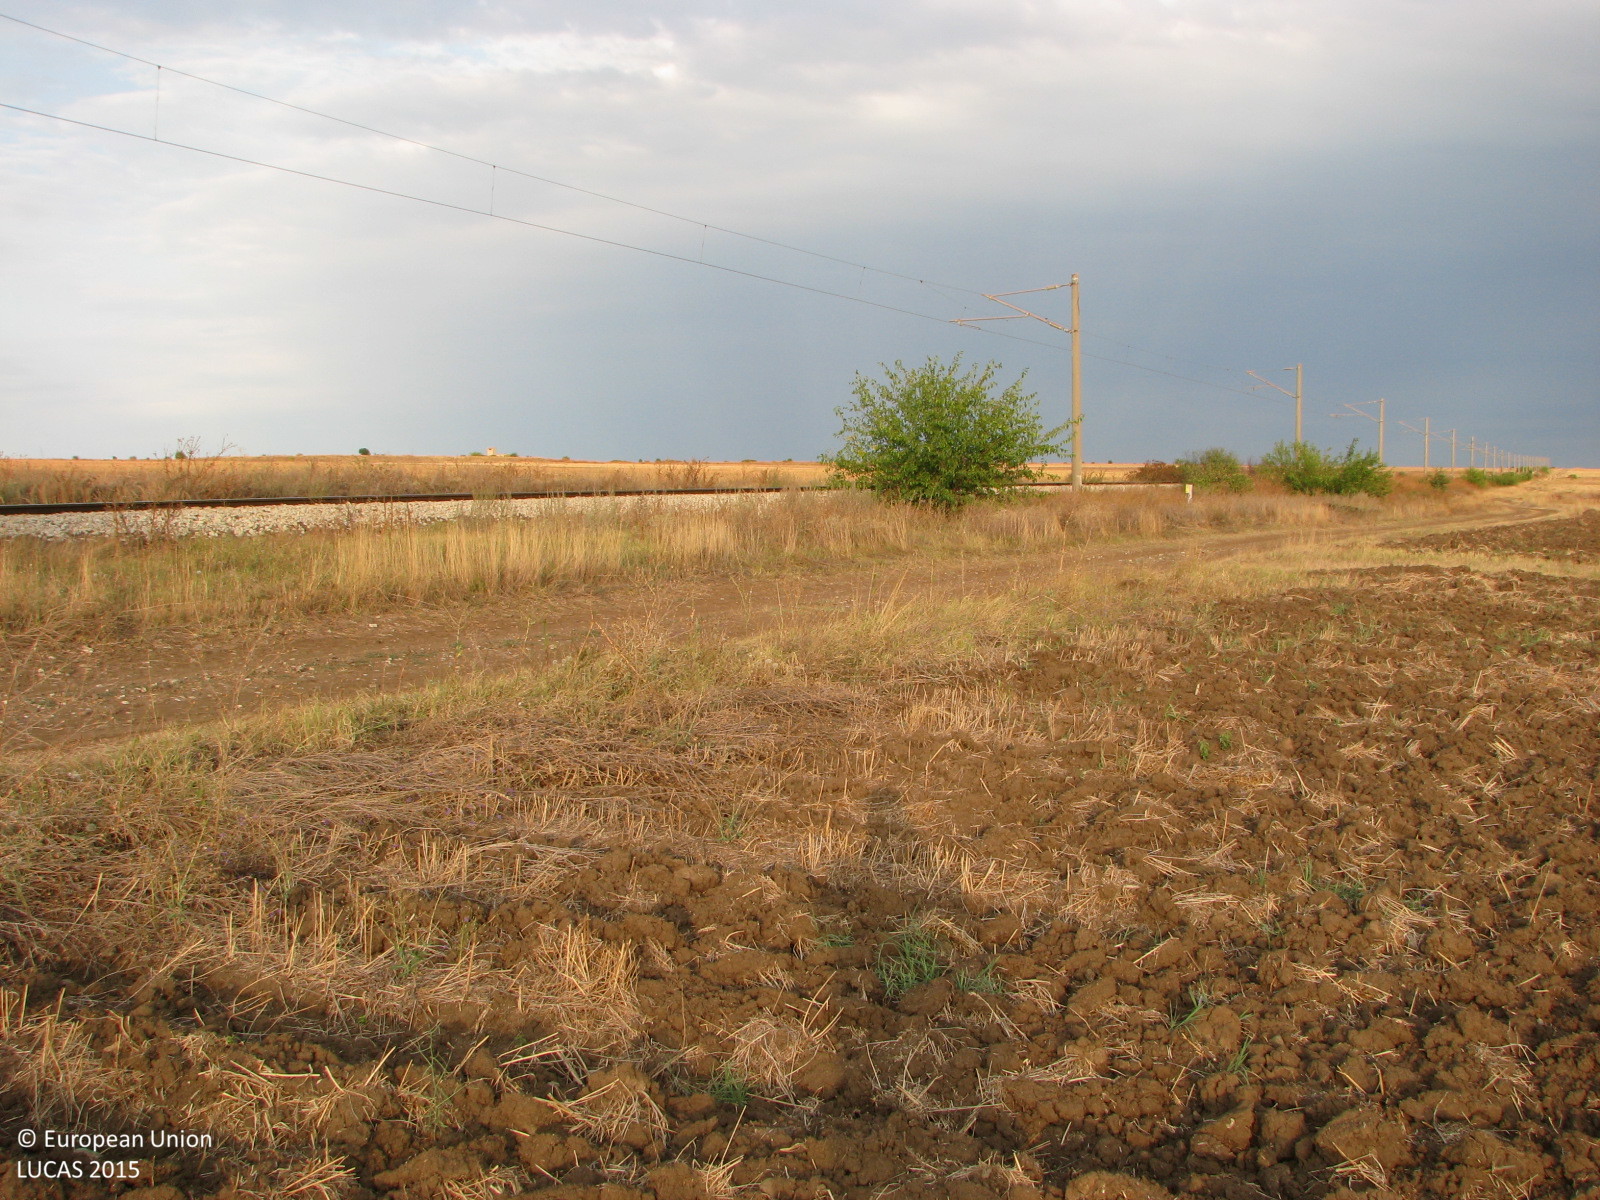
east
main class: Cropland
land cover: Common wheat
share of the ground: < 10 %
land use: Agriculture (excluding fallow land and kitchen gardens)
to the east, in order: Common wheat; Grass margins; Tracks; Grassland with sparse tree/shrub cover; Ditches and canals; Electric lines; Railways; Ditches and canals; Grassland without tree/shrub cover; Tracks; Grassland without tree/shrub cover; Ditches and canals; Tracks; Other bare soil; Sunflower
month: September
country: BG
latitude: 42.5902
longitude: 26.5333
